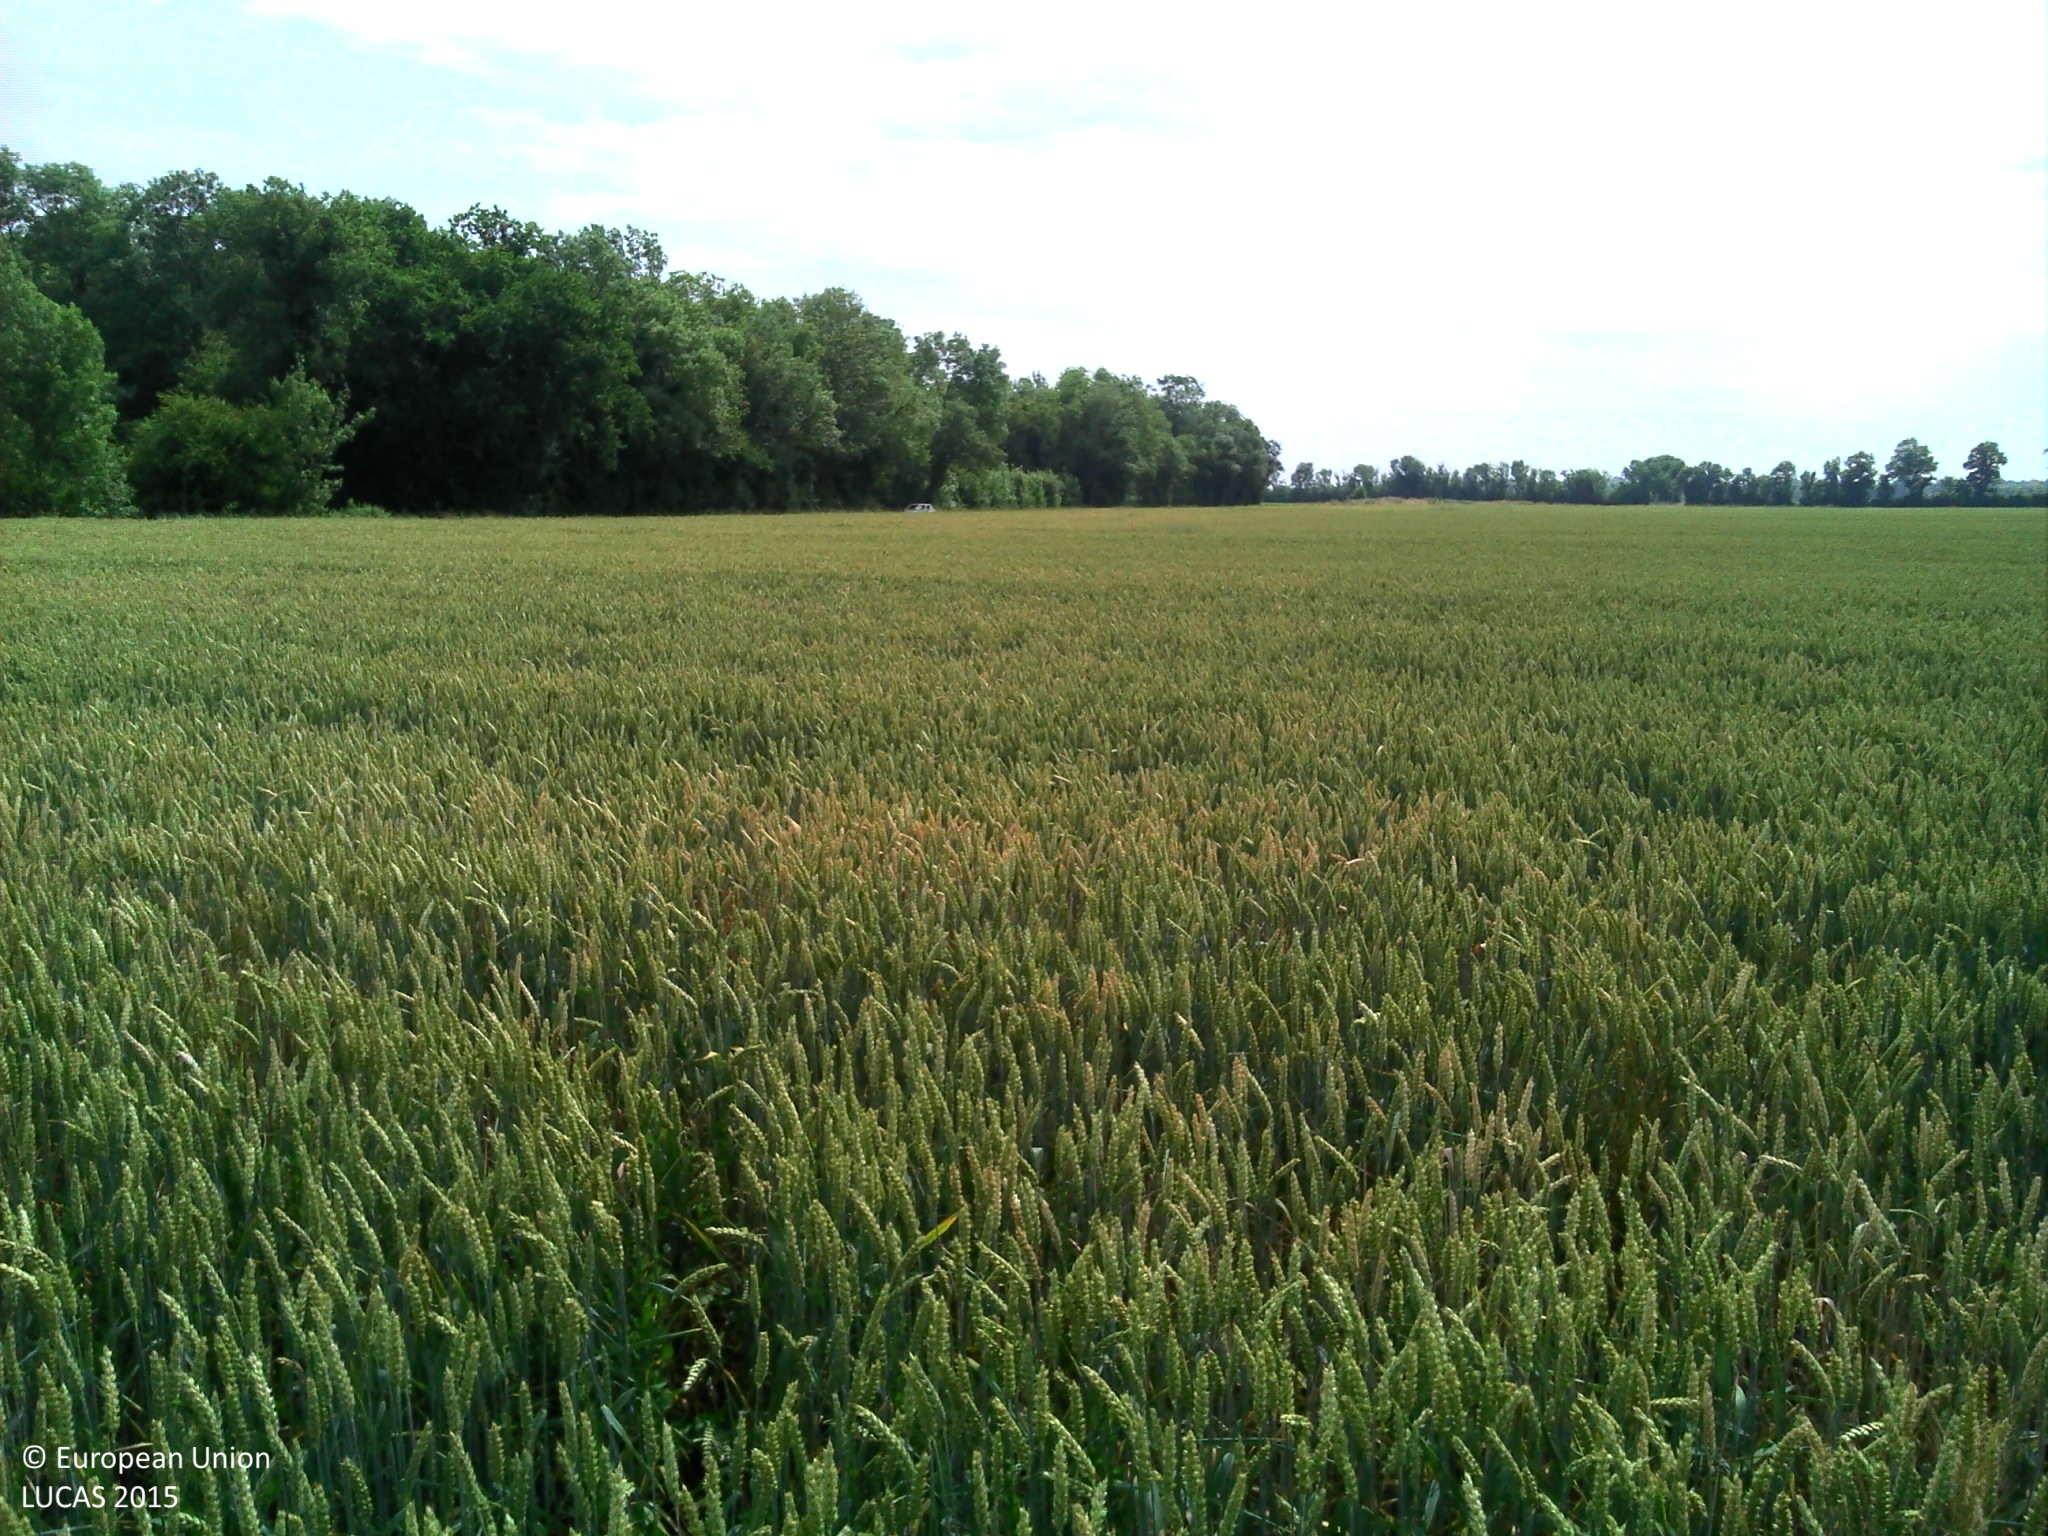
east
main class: Cropland
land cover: Durum wheat
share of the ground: > 75 %
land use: Agriculture (excluding fallow land and kitchen gardens)
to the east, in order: Durum wheat; Grass margins; Ditches and canals; Tracks; Grass margins; Broadleaved woodland; Tracks
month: June
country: FR
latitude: 46.0272
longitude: -0.7363
